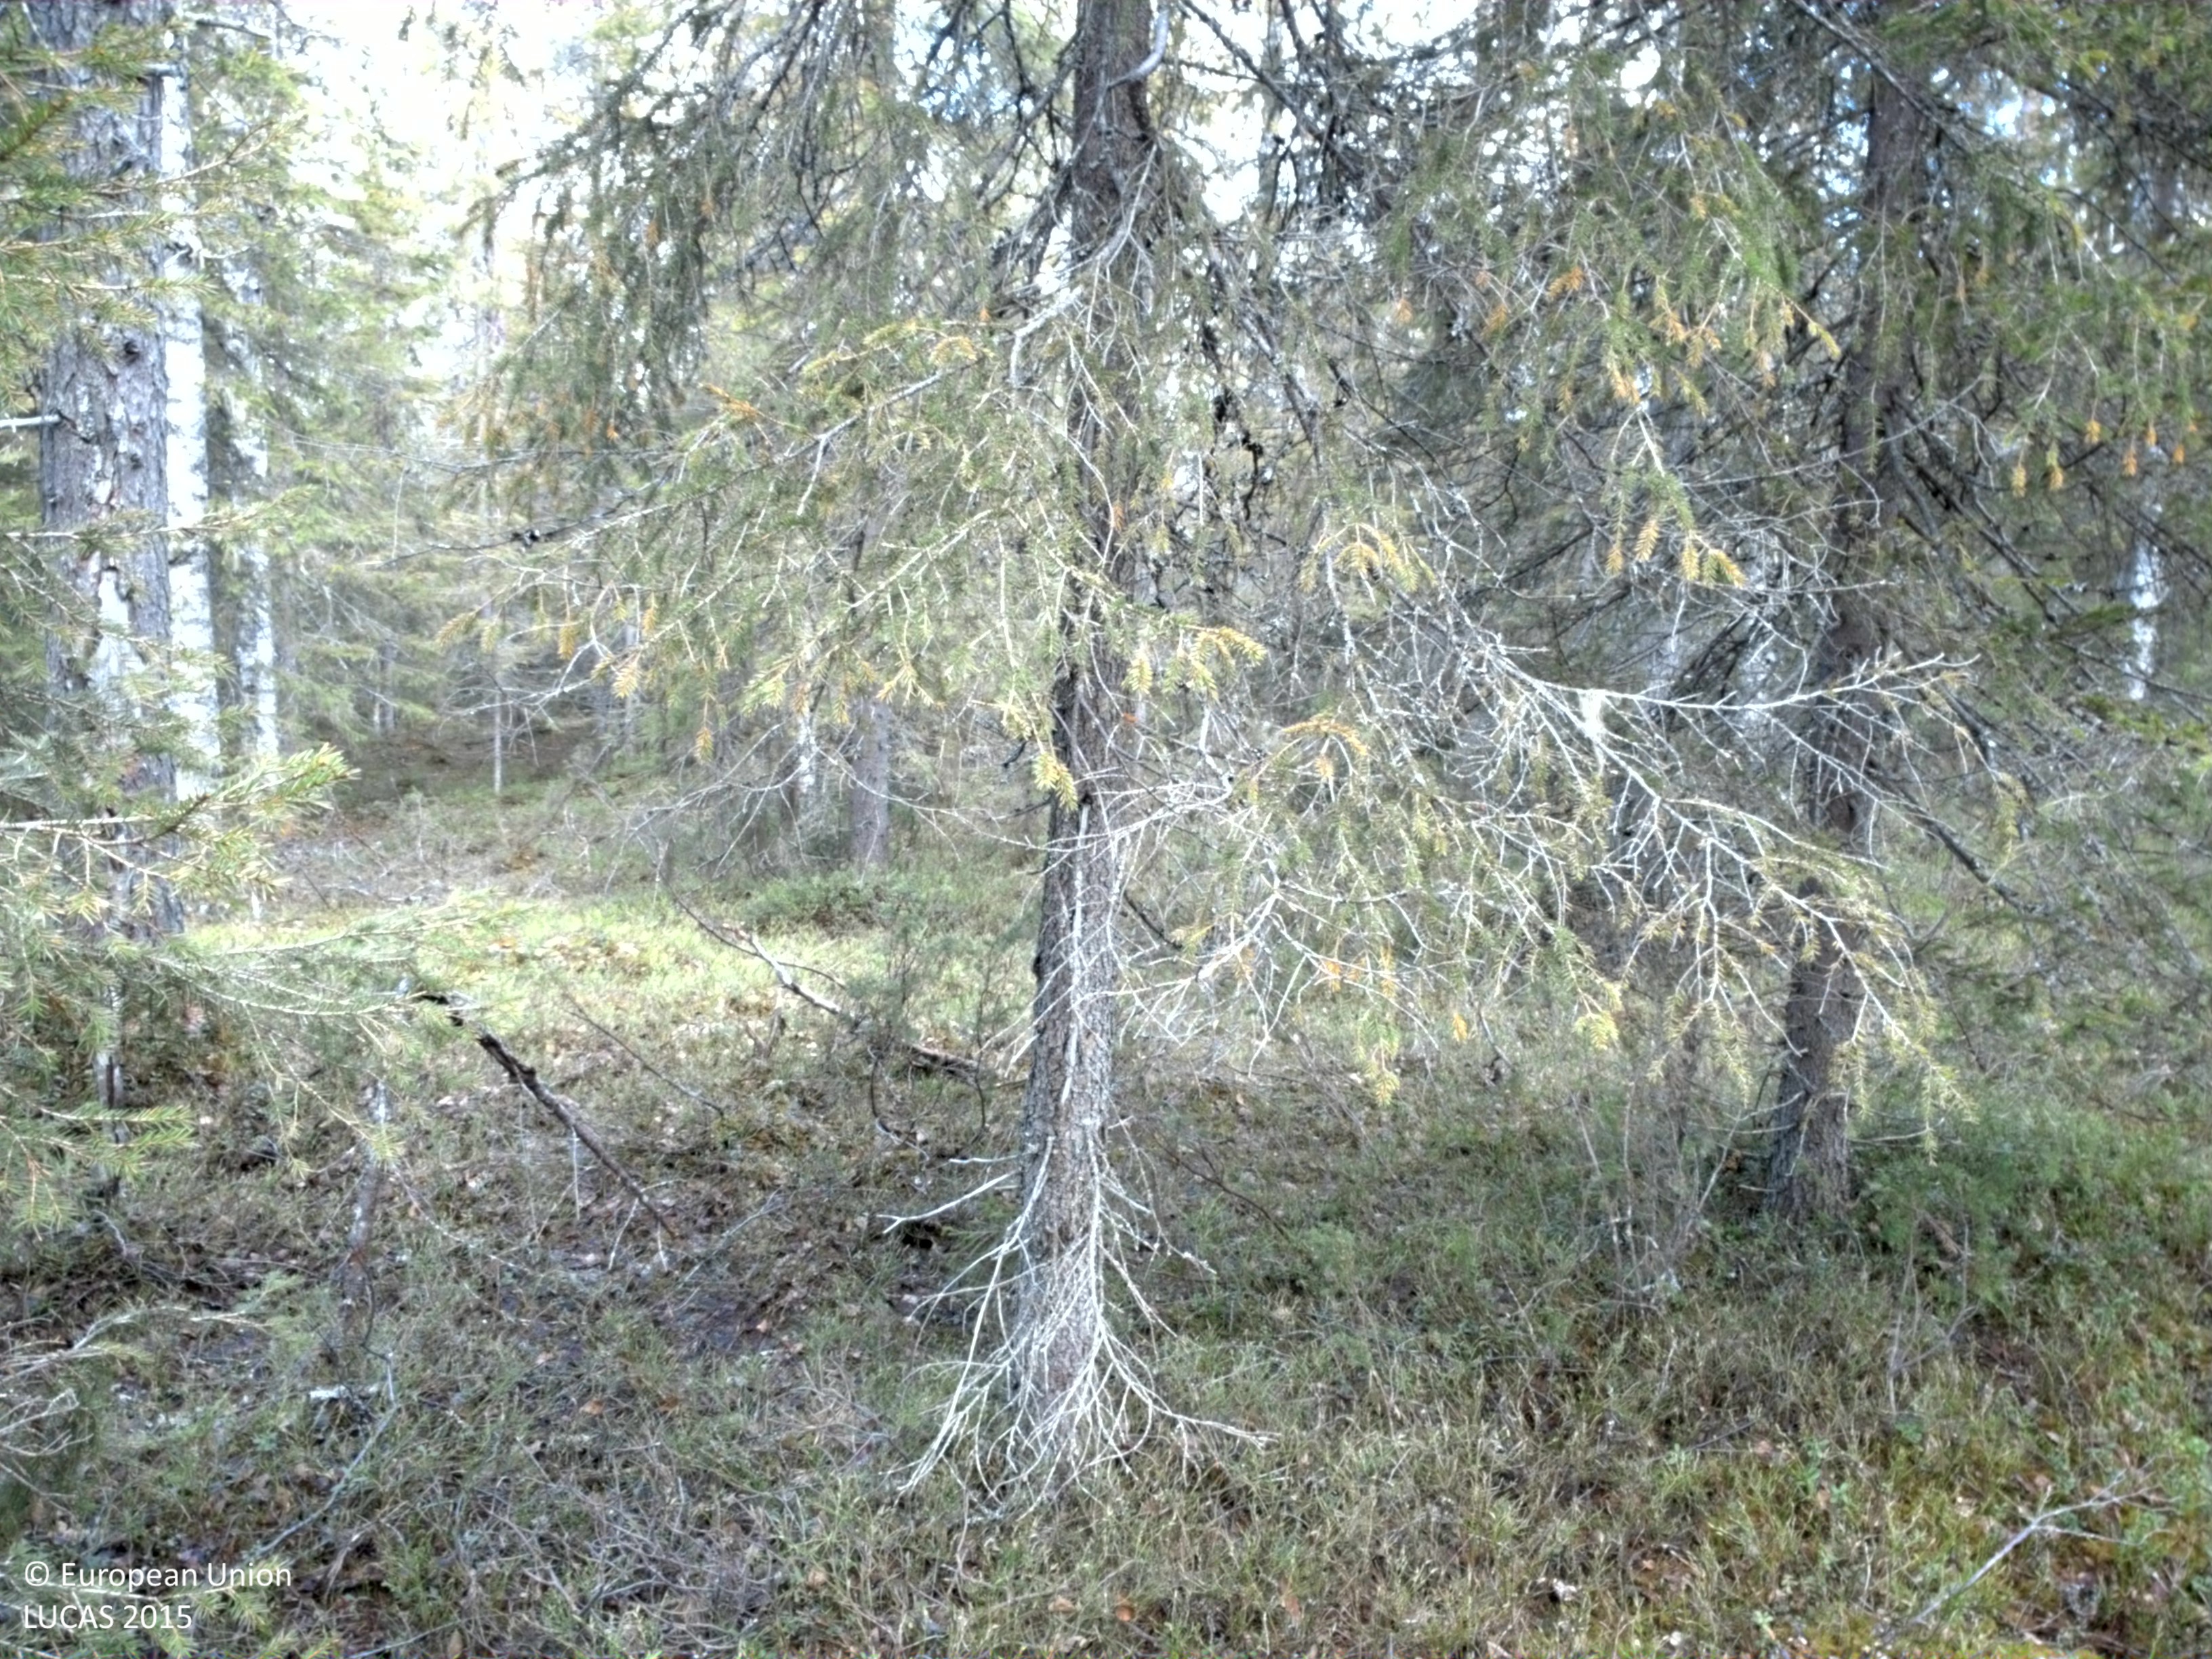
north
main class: Woodland
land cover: Spruce dominated coniferous woodland
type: boreal forest
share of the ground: > 75 %
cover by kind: coniferous forest trees 75 %, shrubs 15 %, broadleaved forest trees 10 %
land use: Forestry
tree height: > 5 m
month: June
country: SE
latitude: 66.4309
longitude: 23.2721
